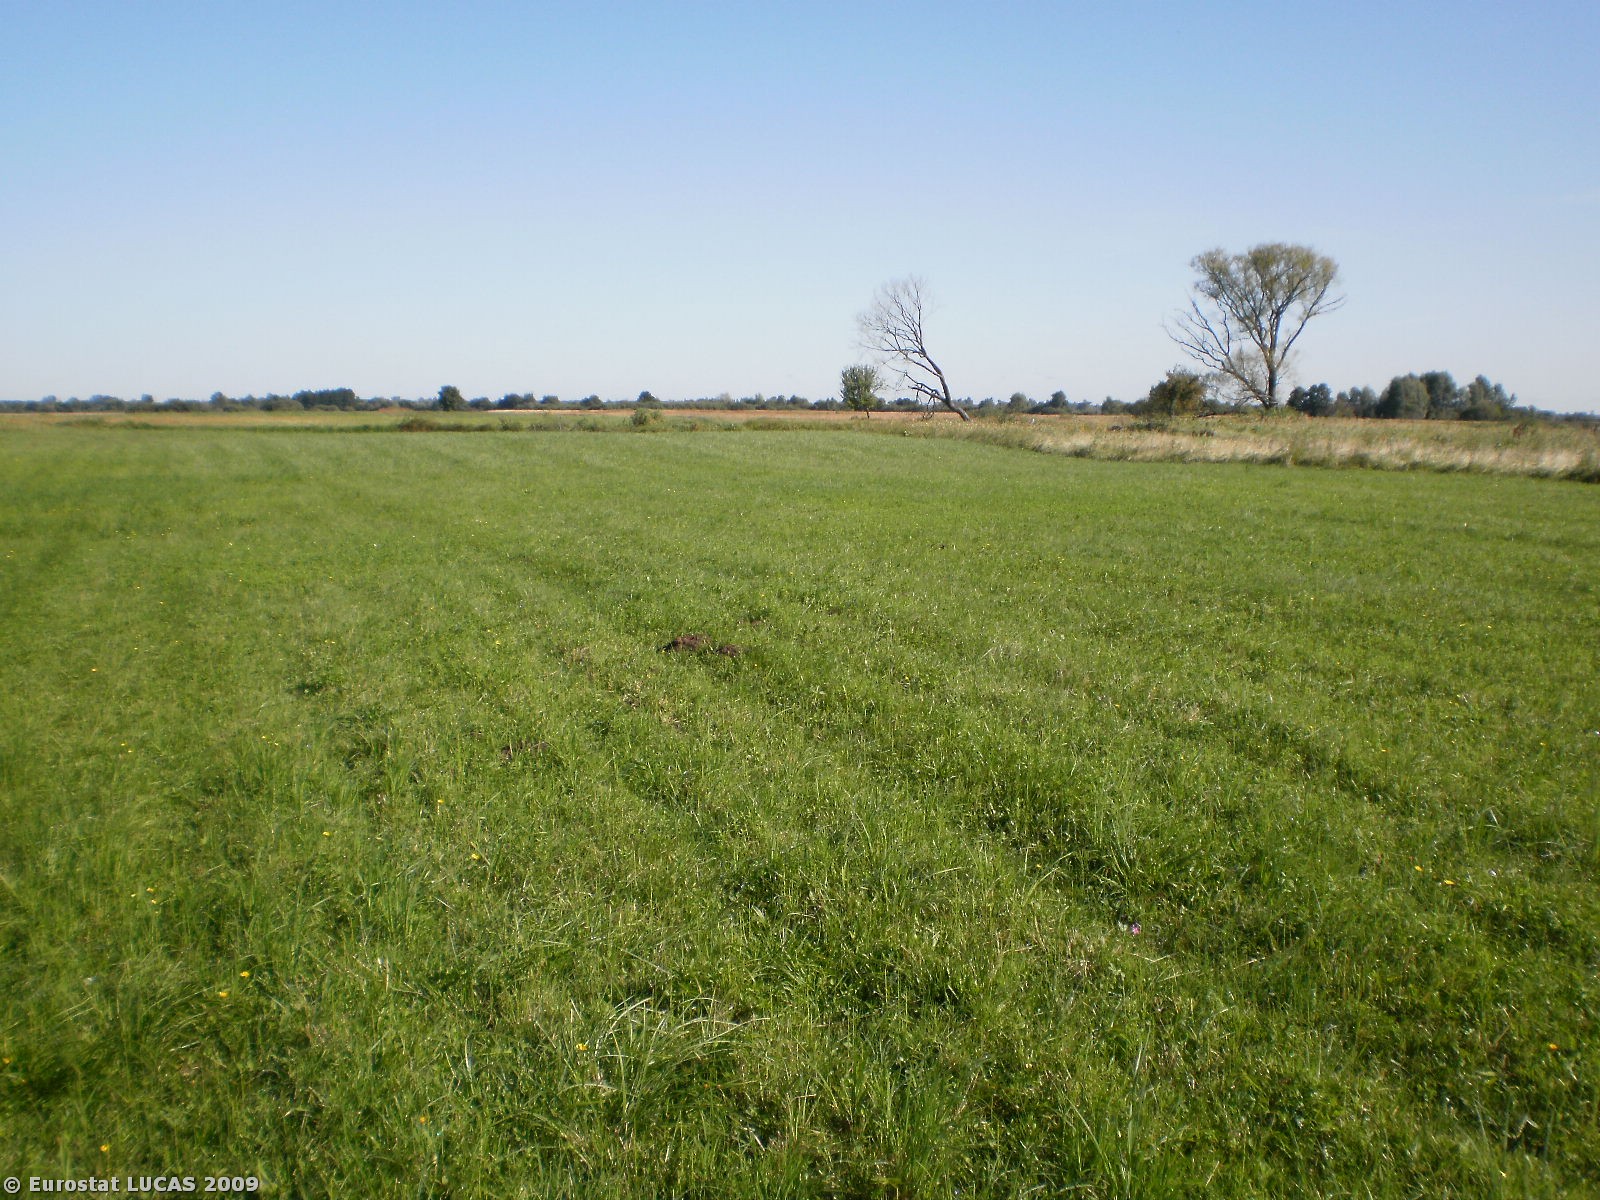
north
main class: Grassland
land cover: Grassland without tree/shrub cover
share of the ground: > 75 %
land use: Agriculture (excluding fallow land and kitchen gardens)
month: August
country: PL
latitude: 52.6137
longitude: 21.7065
